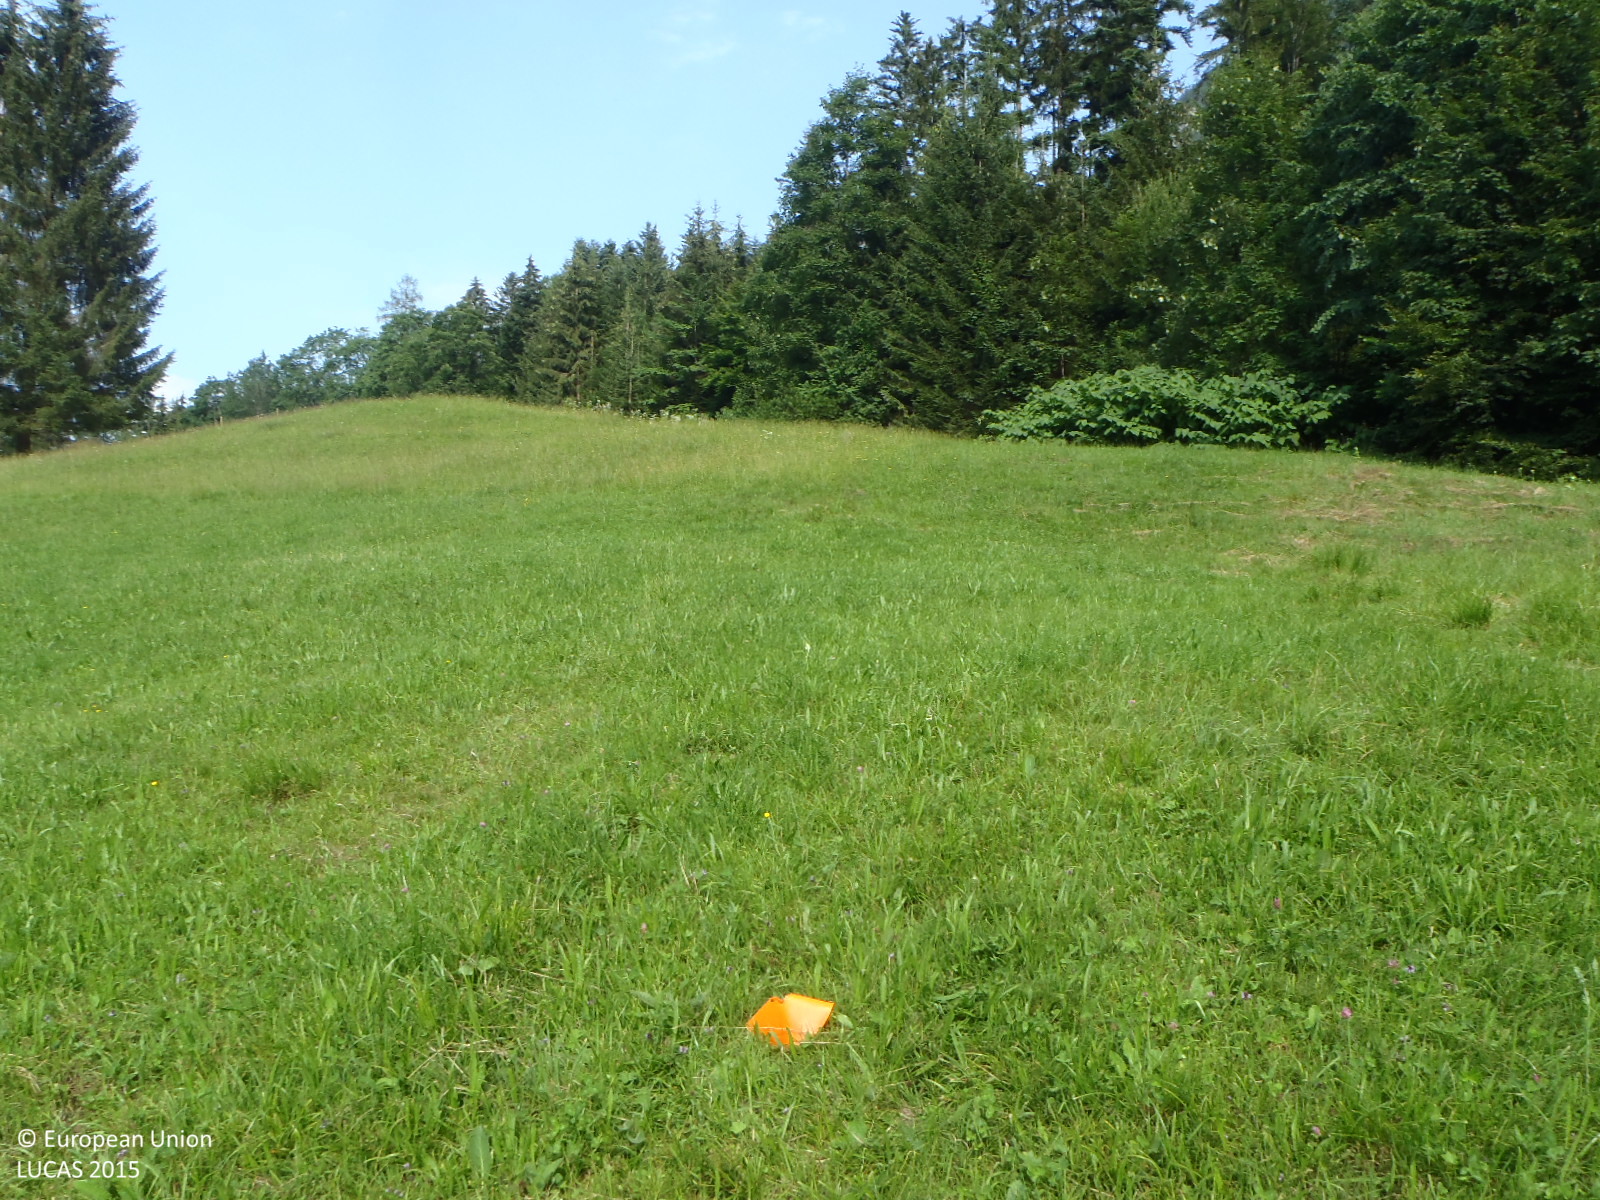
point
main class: Grassland
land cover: Grassland without tree/shrub cover
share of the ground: > 75 %
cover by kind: herbaceous plants 100 %
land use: Agriculture (excluding fallow land and kitchen gardens)
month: July
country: AT
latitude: 47.5187
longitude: 12.1365
